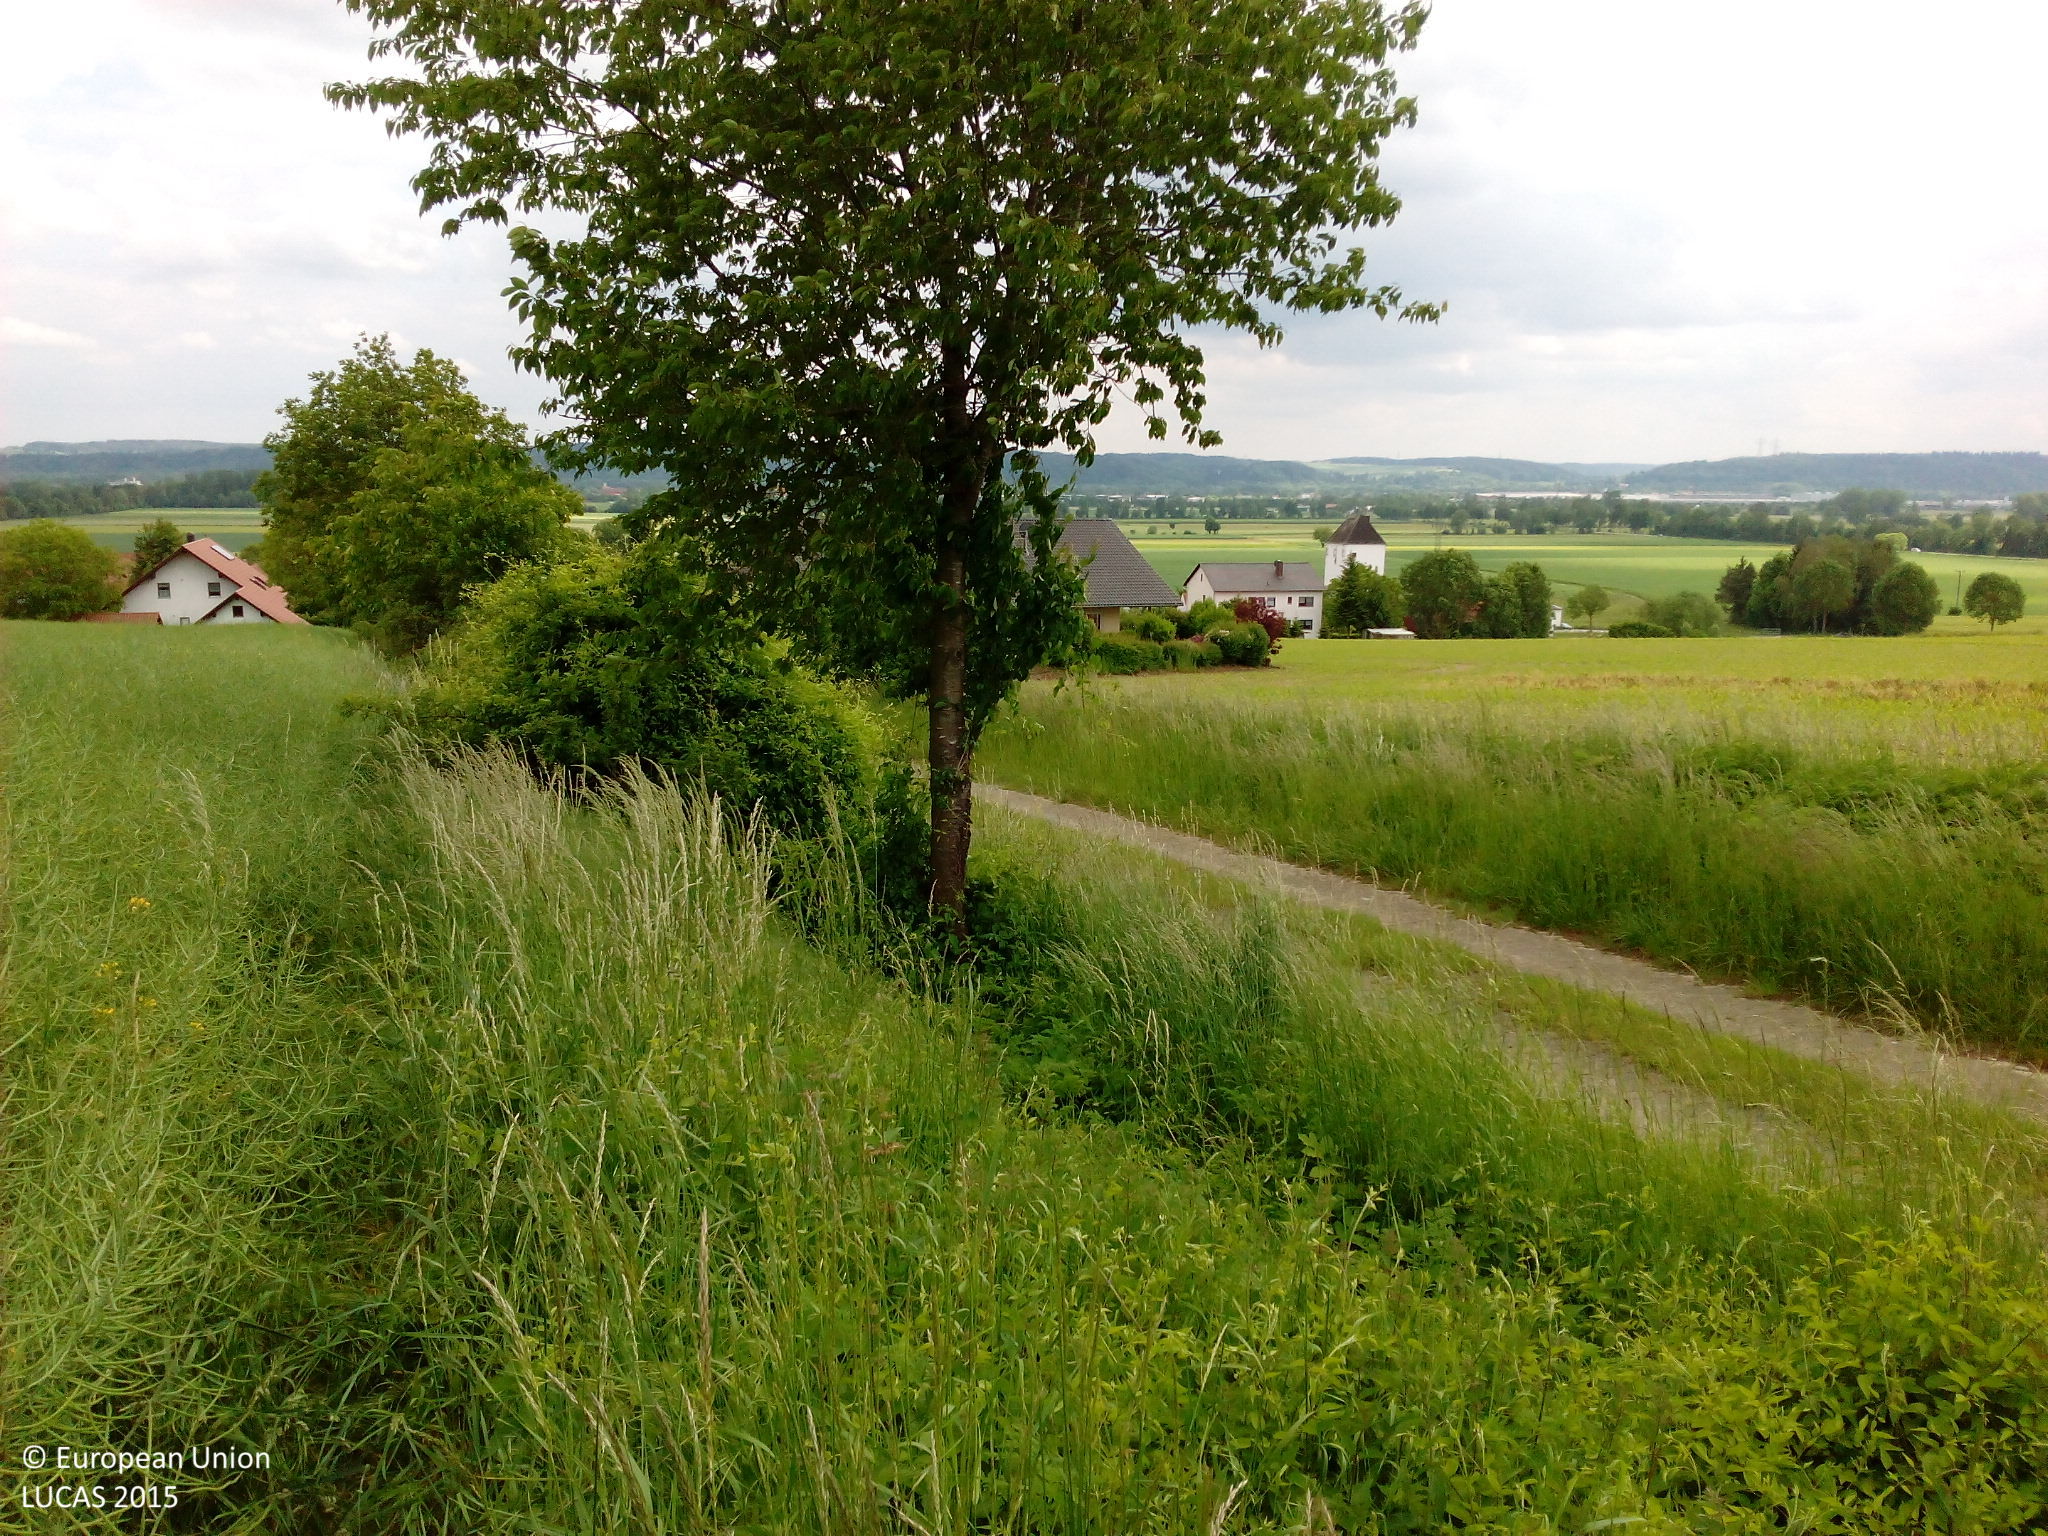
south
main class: Cropland
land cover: Rape and turnip rape
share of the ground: > 75 %
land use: Agriculture (excluding fallow land and kitchen gardens)
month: May
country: DE
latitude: 48.6492
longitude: 12.3203
